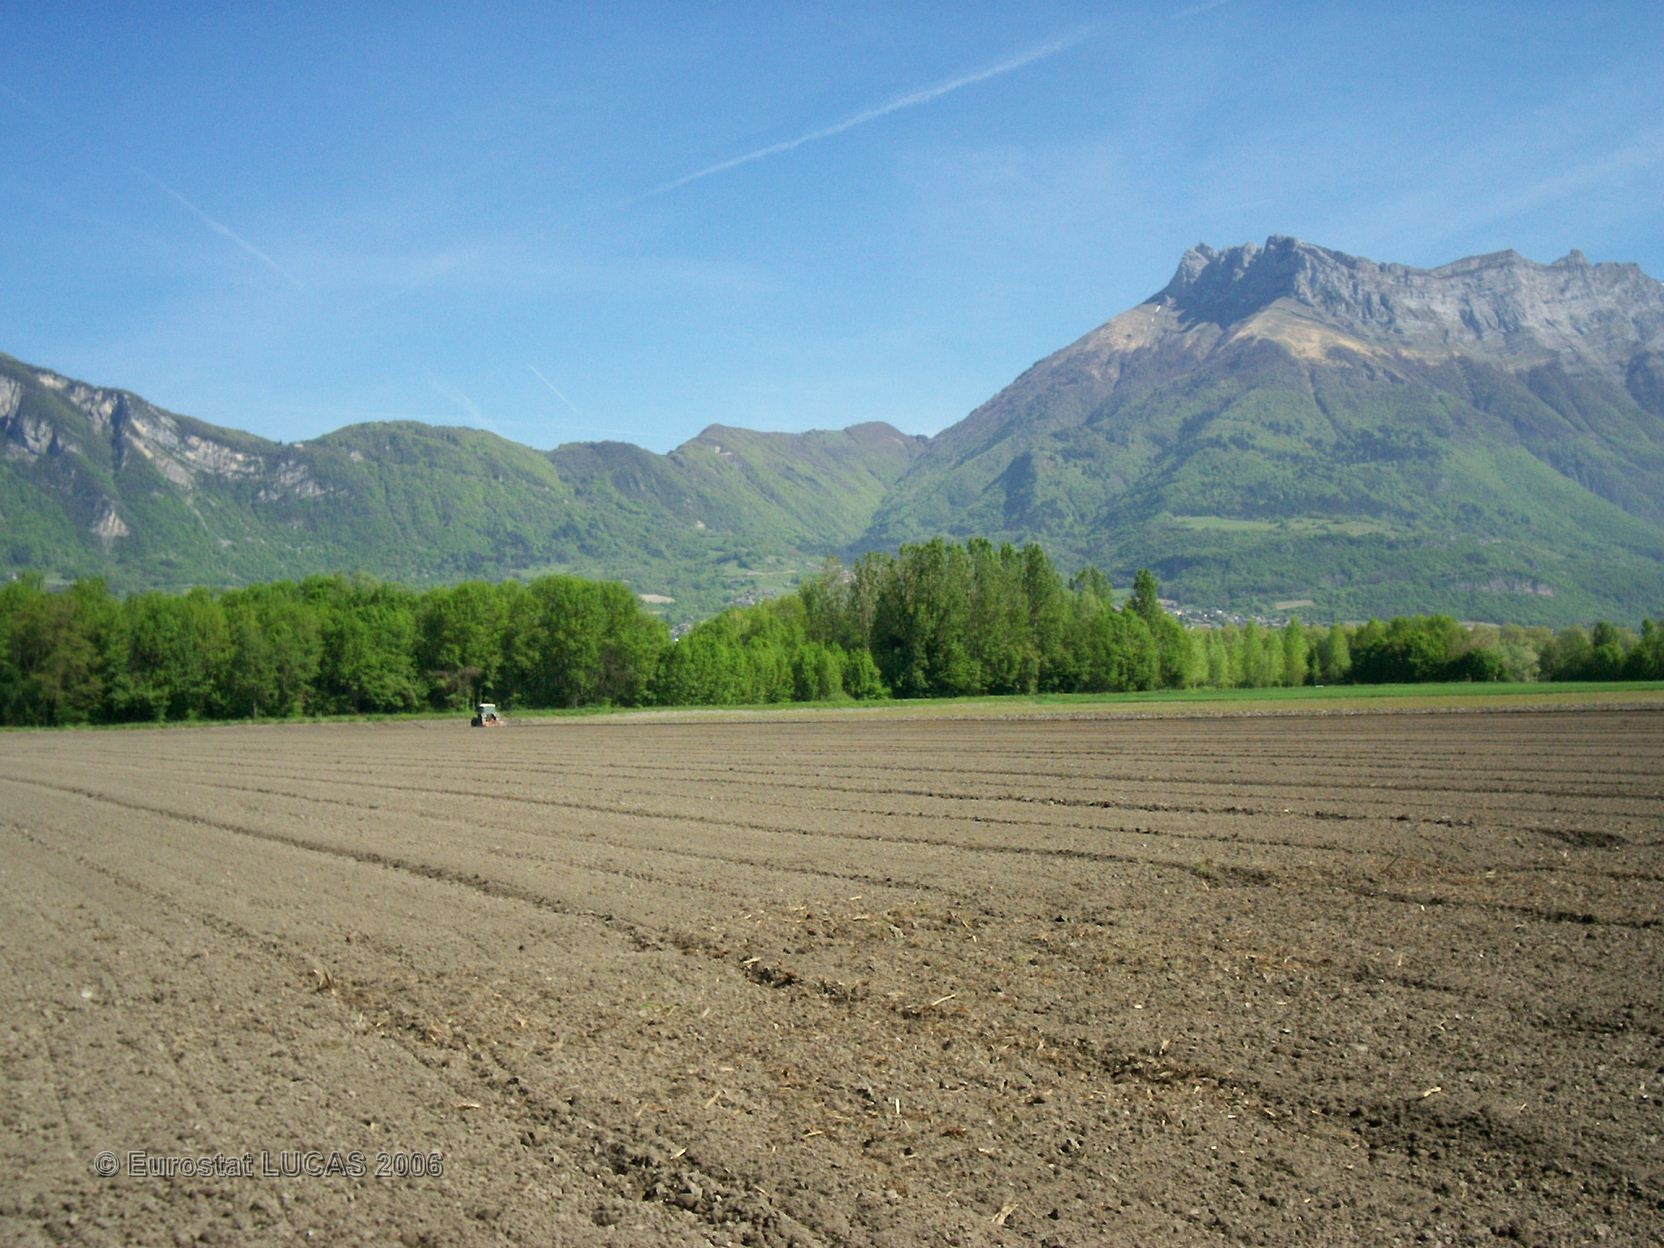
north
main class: Cropland
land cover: Maize
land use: Agriculture (excluding fallow land and kitchen gardens)
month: June
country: FR
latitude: 45.5425
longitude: 6.1496
